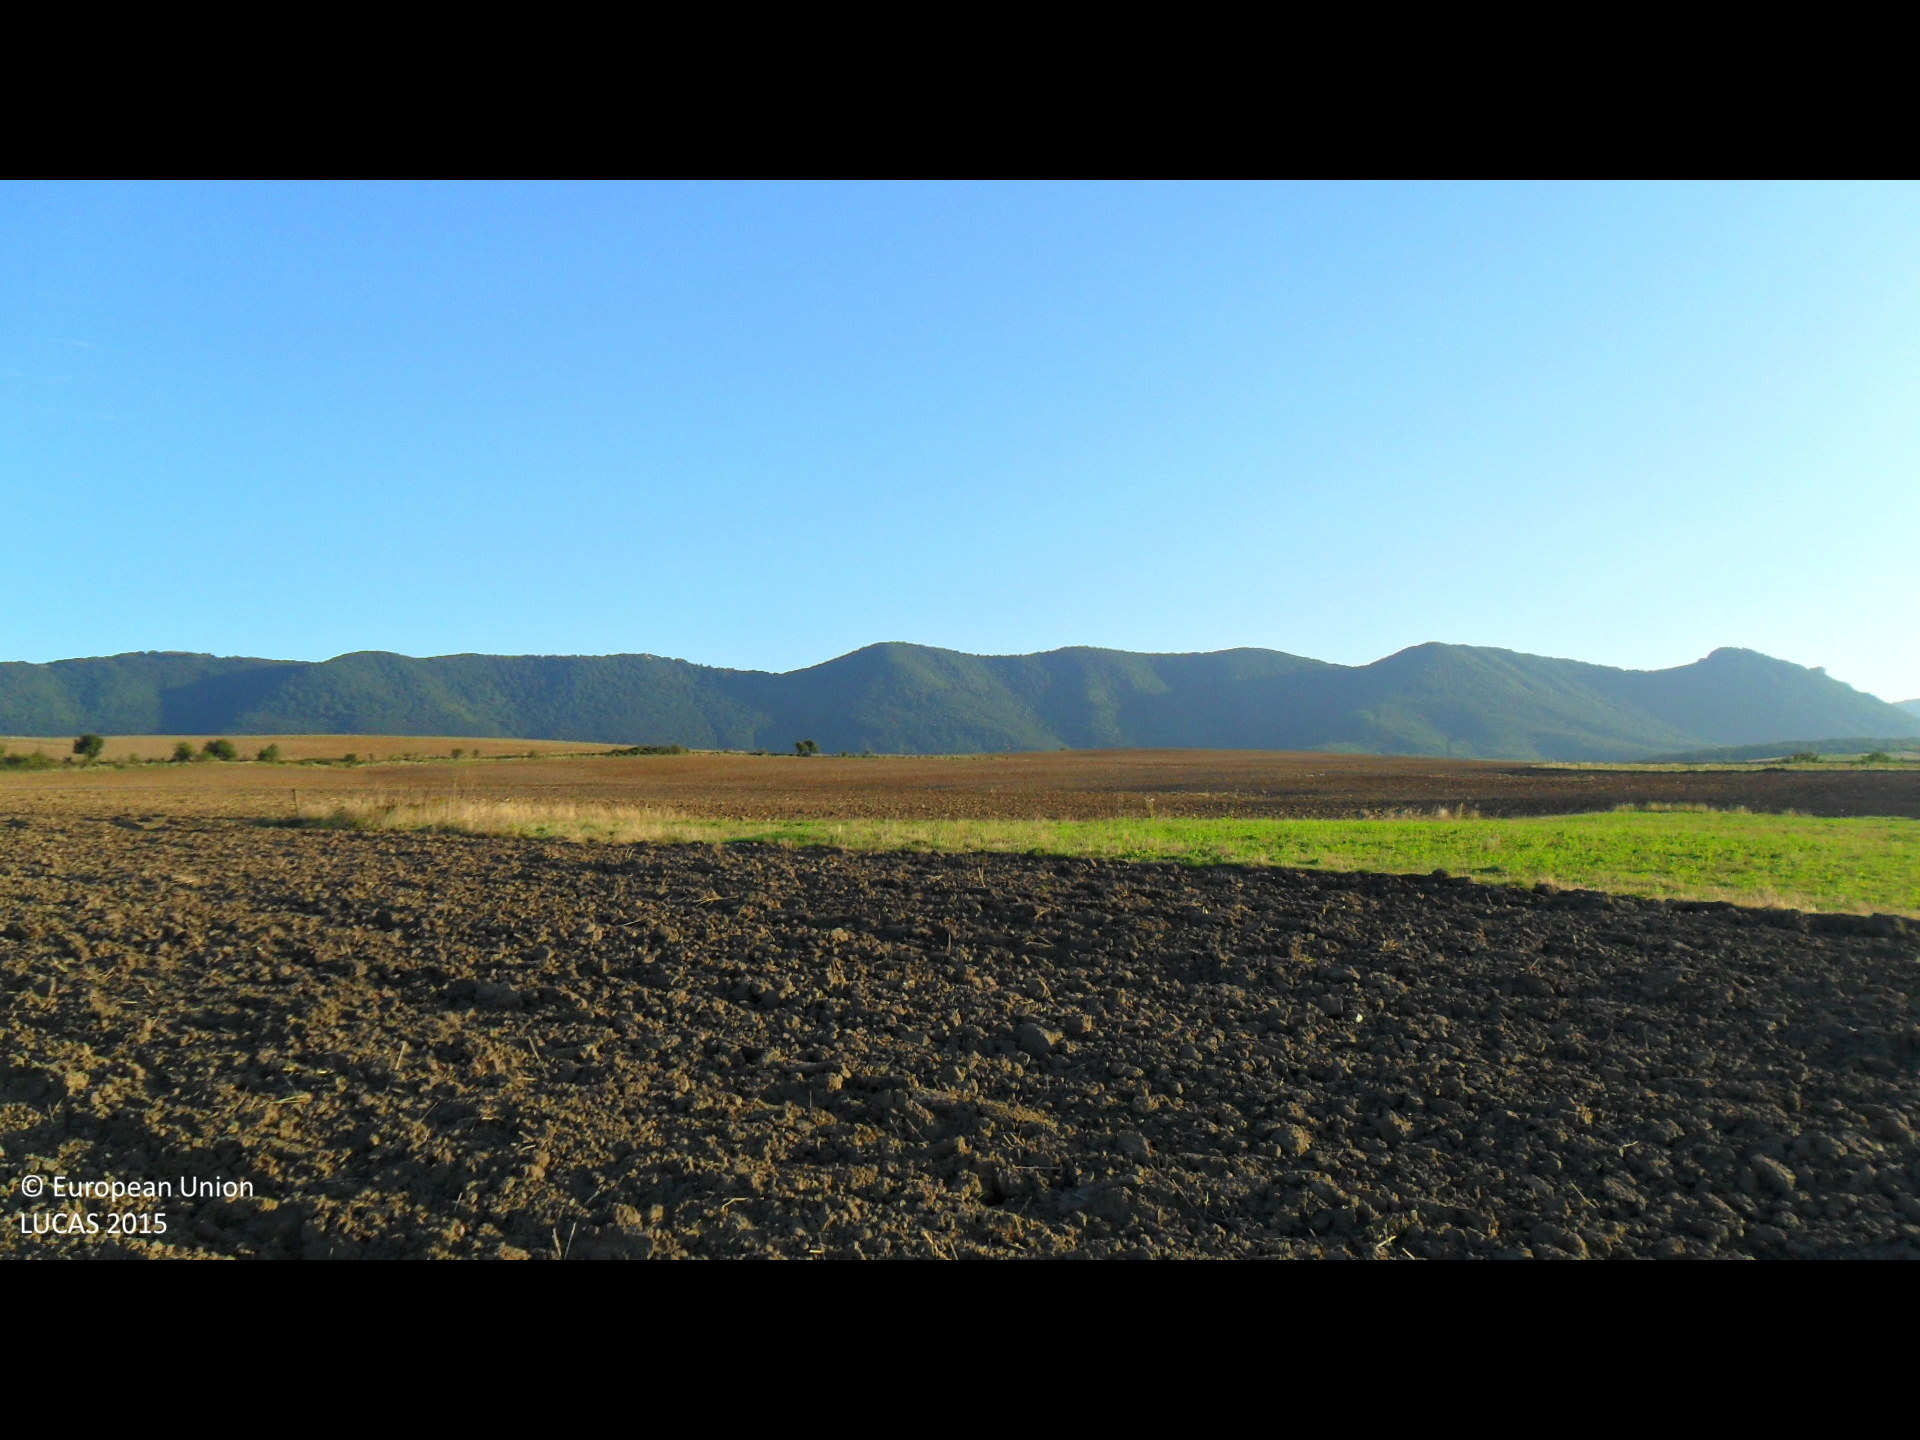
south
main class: Cropland
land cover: Common wheat
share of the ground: < 10 %
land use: Agriculture (excluding fallow land and kitchen gardens)
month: September
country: BG
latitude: 42.9885
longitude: 26.5713
